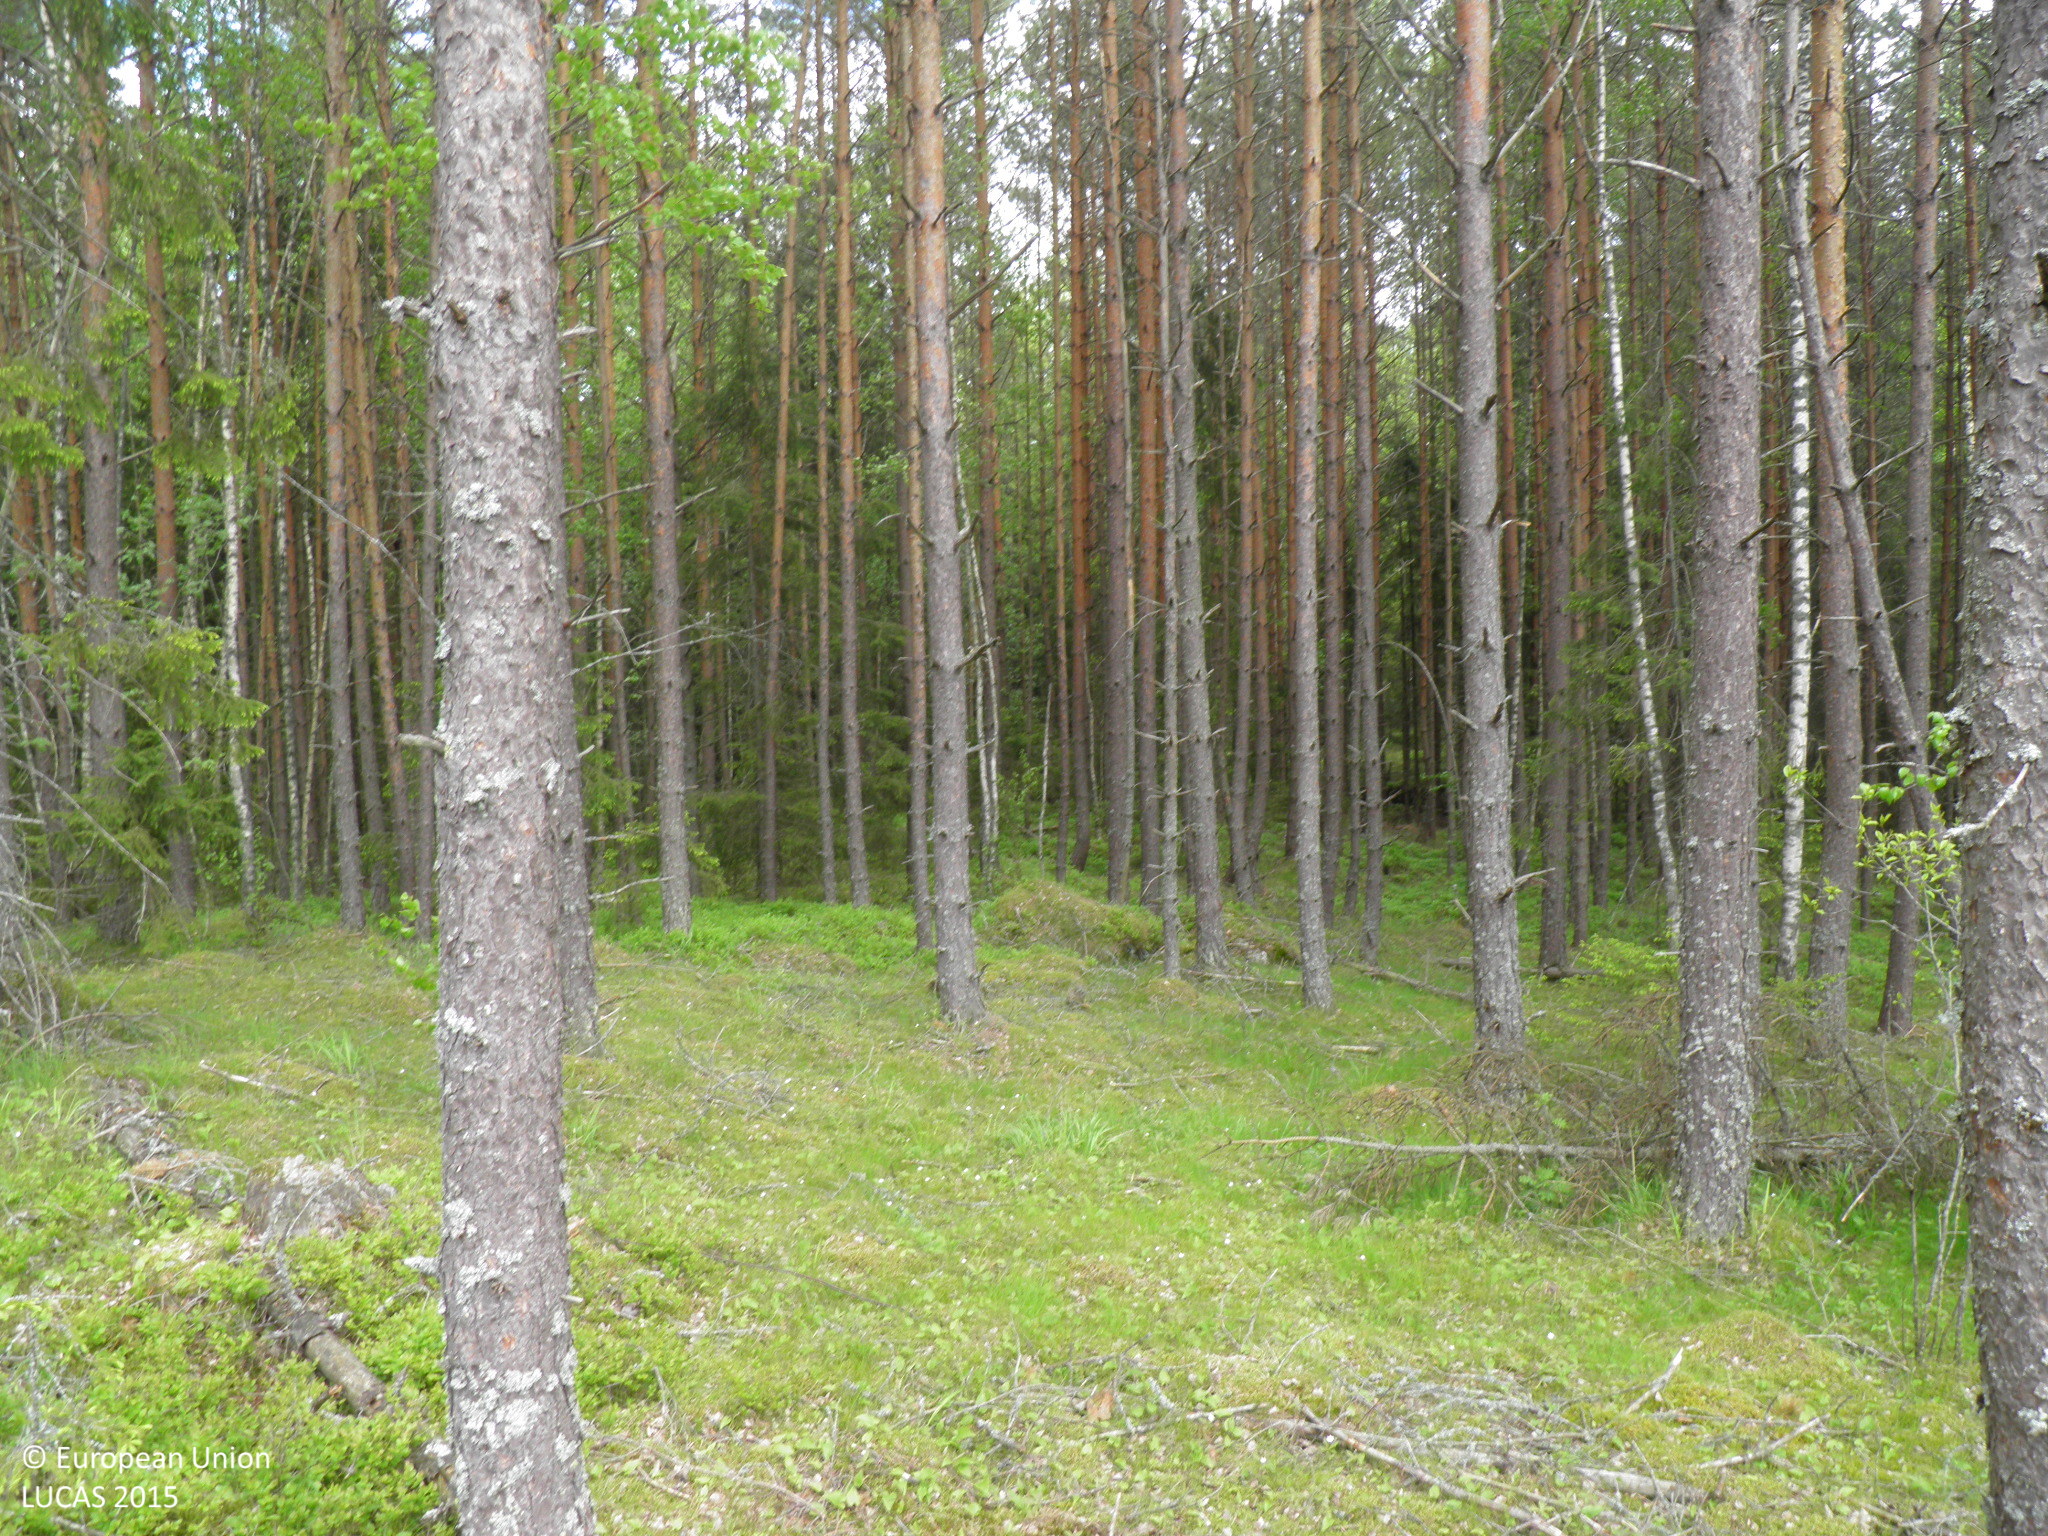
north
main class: Woodland
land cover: Pine dominated mixed woodland
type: hemiboreal forest and nemoral coniferous forest and mixed broadleaved-coniferous forest
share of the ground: > 75 %
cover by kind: coniferous forest trees 60 %, broadleaved forest trees 20 %, herbaceous plants 15 %, shrubs 5 %
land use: Forestry
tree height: > 5 m
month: June
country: FI
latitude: 60.5978
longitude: 22.6164
